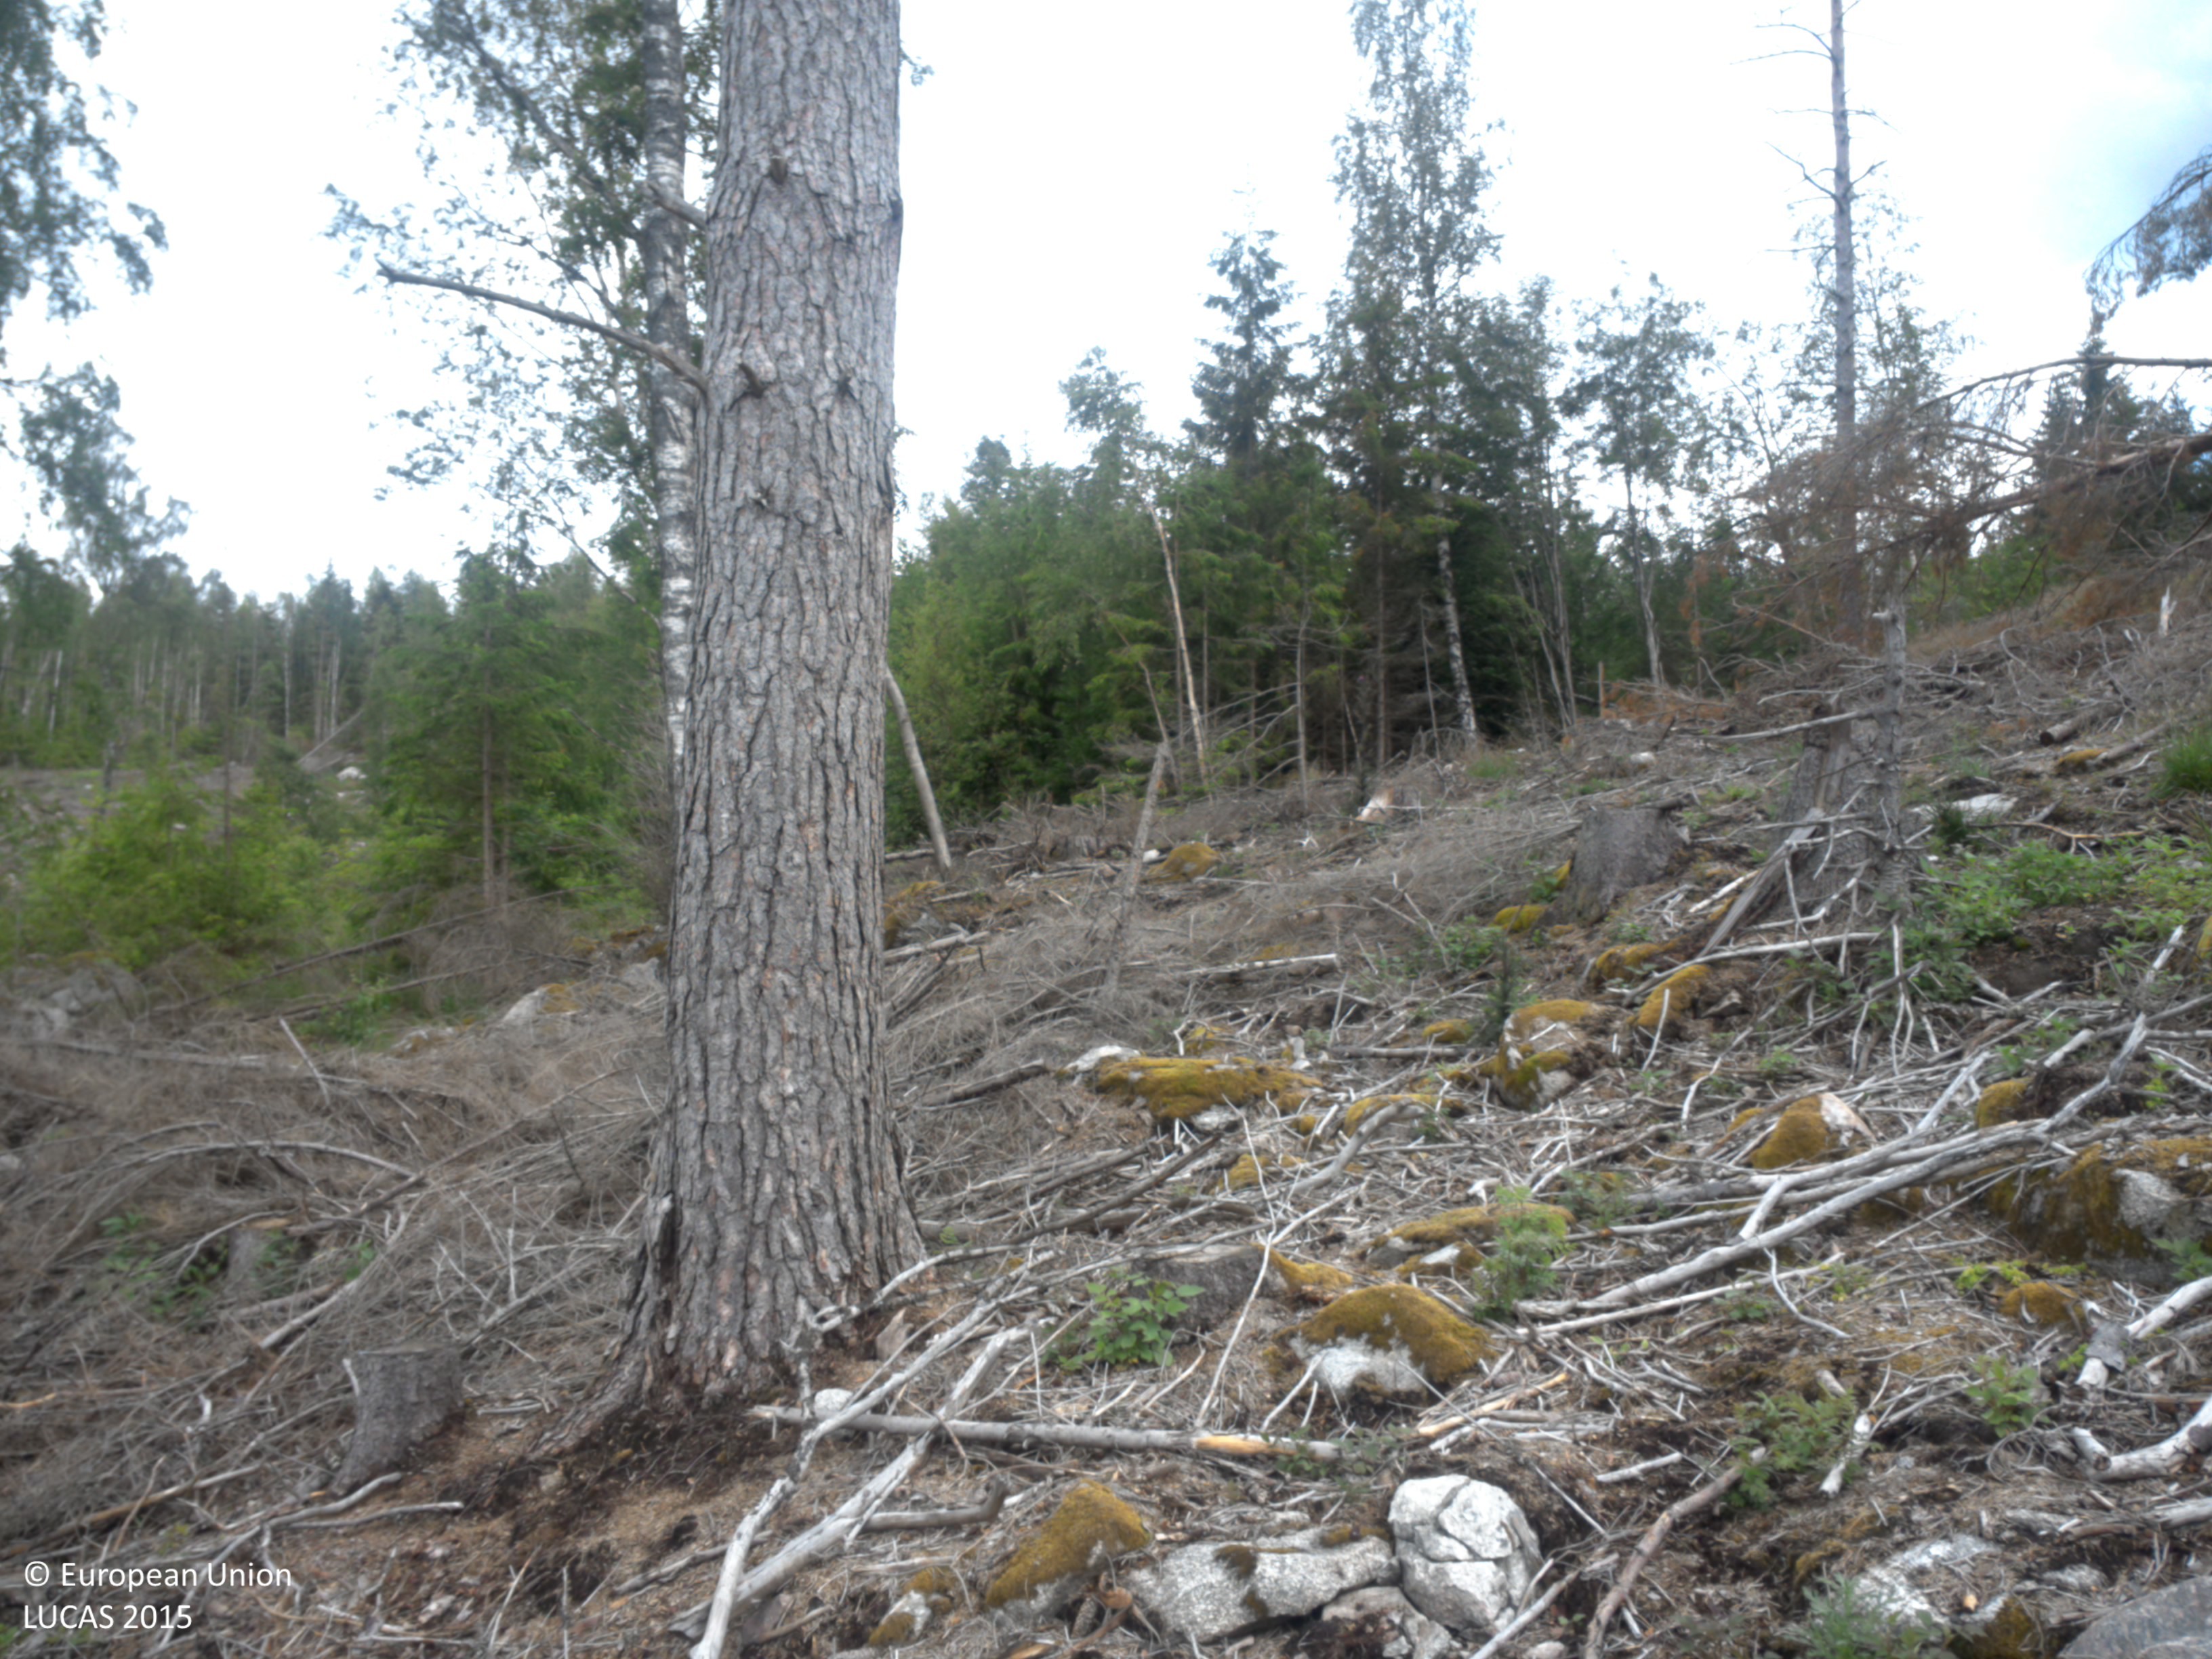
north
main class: Grassland
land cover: Grassland with sparse tree/shrub cover
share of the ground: 25 - 50 %
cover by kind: herbaceous plants 30 %, lichens and mosses 10 %, coniferous forest trees 5 %, shrubs 5 %
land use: Forestry
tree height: > 5 m
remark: Clear cut
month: June
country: SE
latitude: 59.1422
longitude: 11.8658
